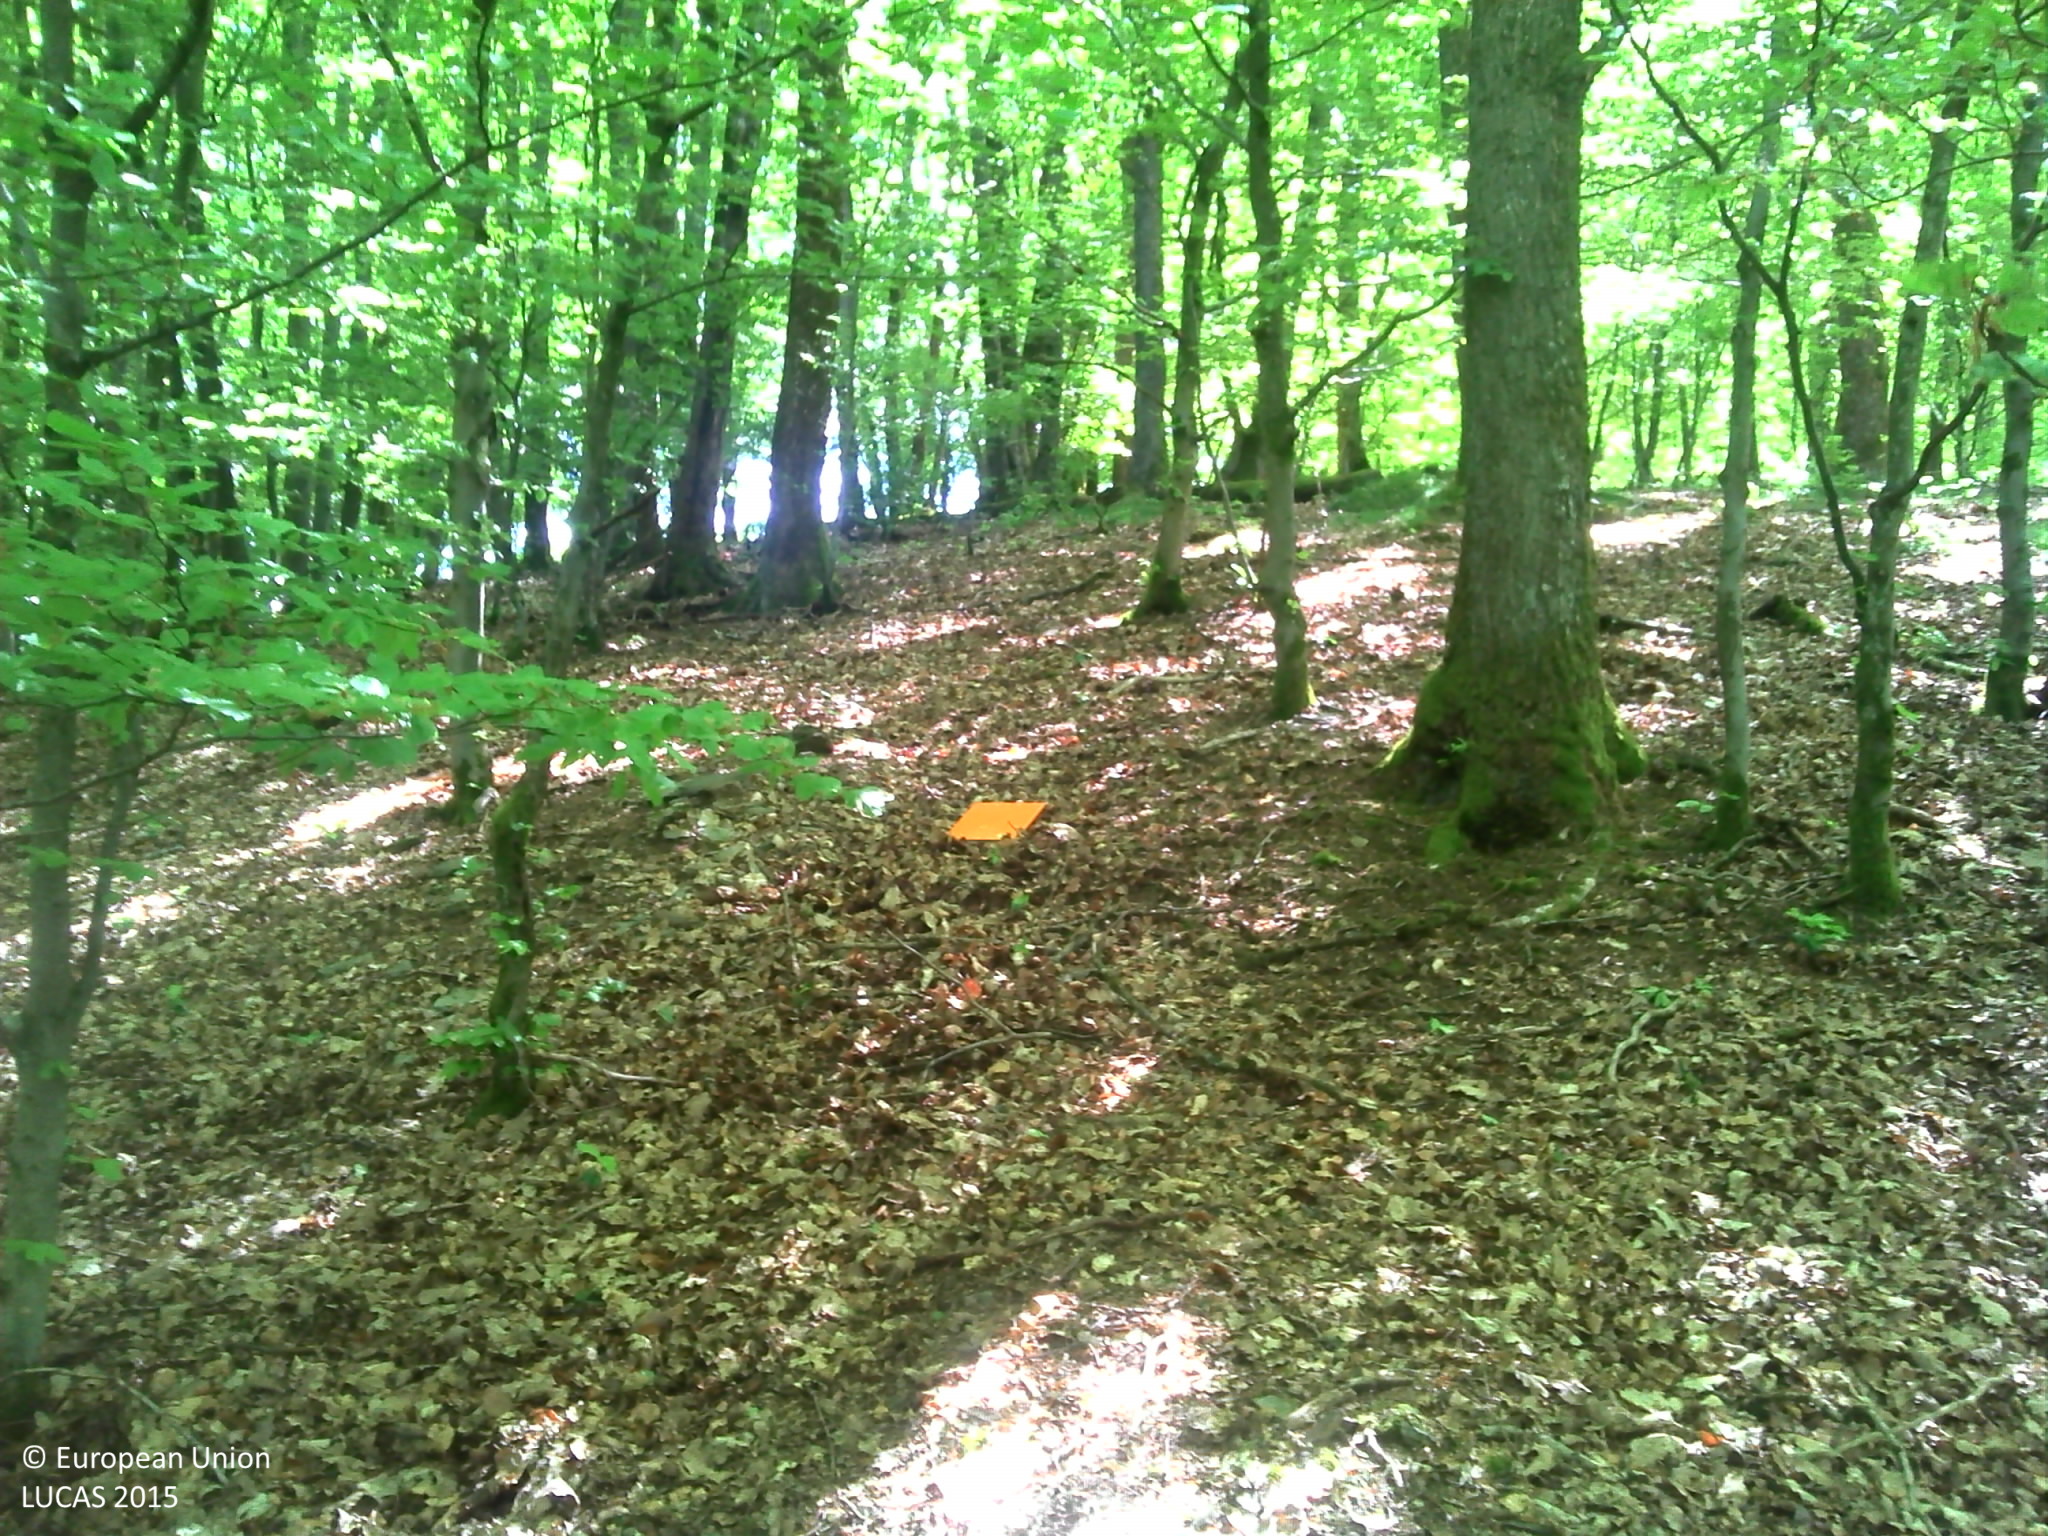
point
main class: Woodland
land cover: Broadleaved woodland
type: acidophilous oak and oak-birch forest
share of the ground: > 75 %
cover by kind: broadleaved forest trees 100 %
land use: Forestry
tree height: > 5 m
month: May
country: LU
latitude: 49.8583
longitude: 5.8955
